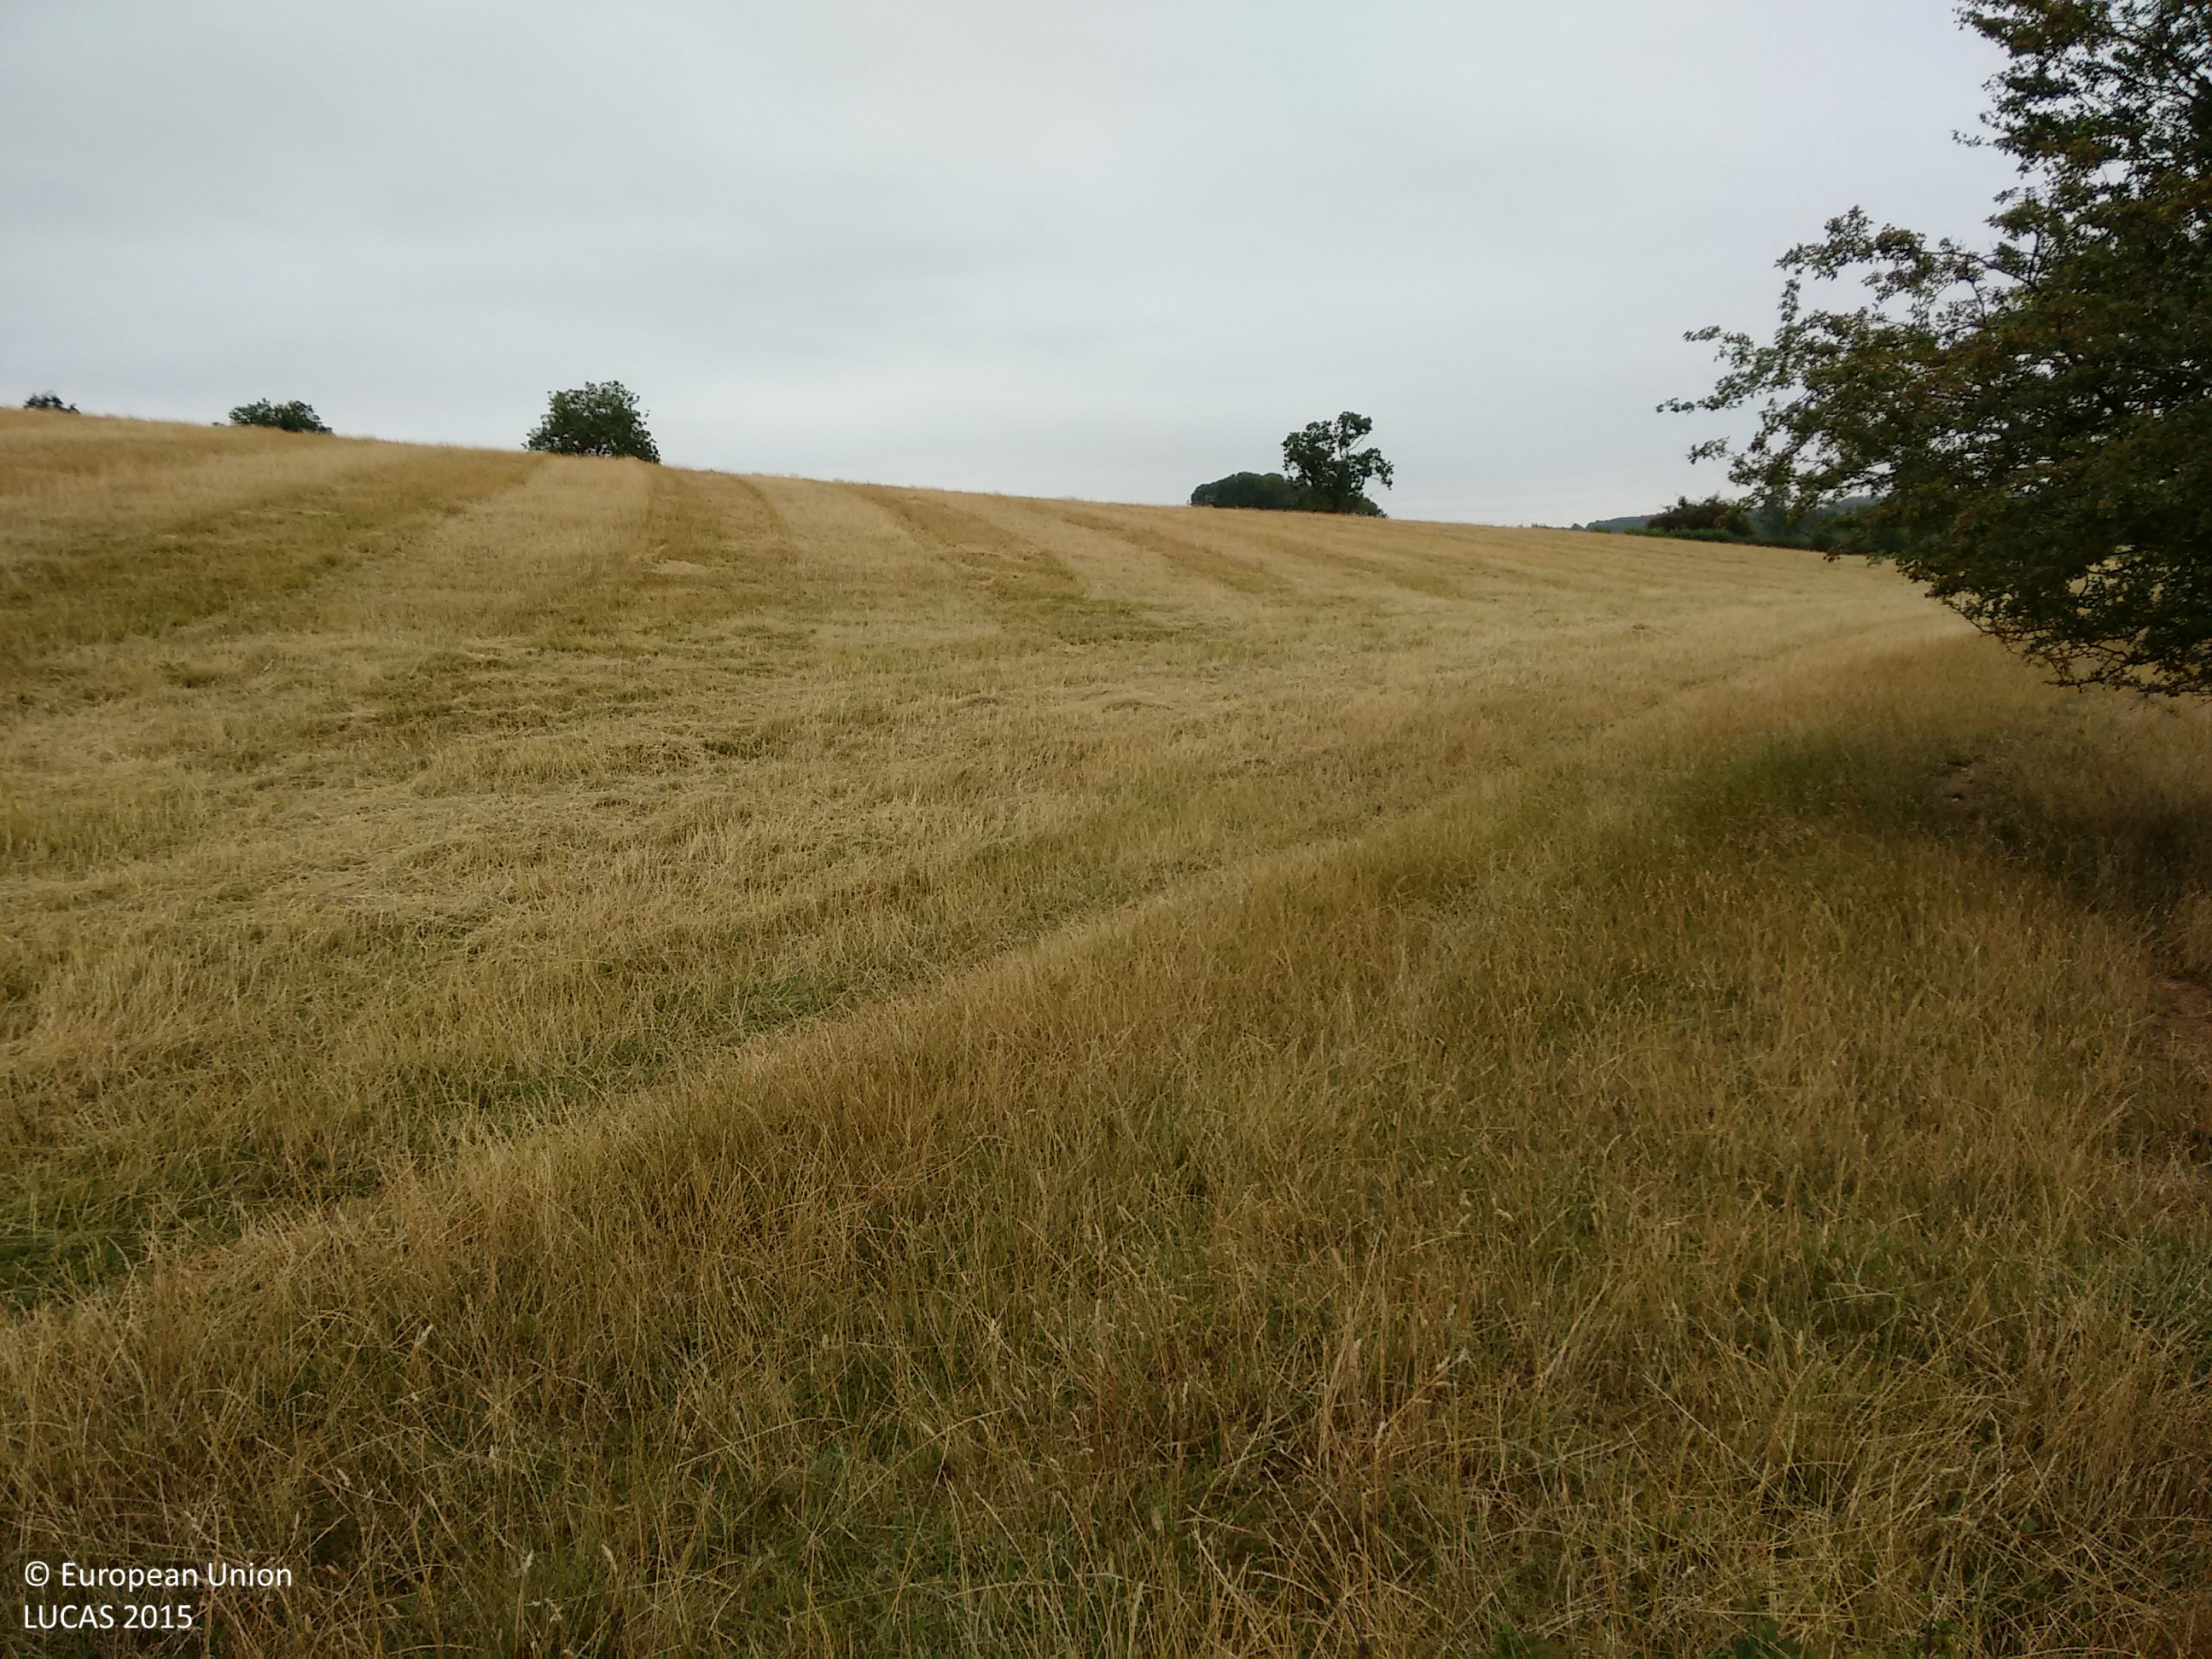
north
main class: Grassland
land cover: Grassland without tree/shrub cover
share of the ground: > 75 %
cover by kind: herbaceous plants 100 %
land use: Agriculture (excluding fallow land and kitchen gardens)
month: August
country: GB
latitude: 52.2738
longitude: -0.6951
